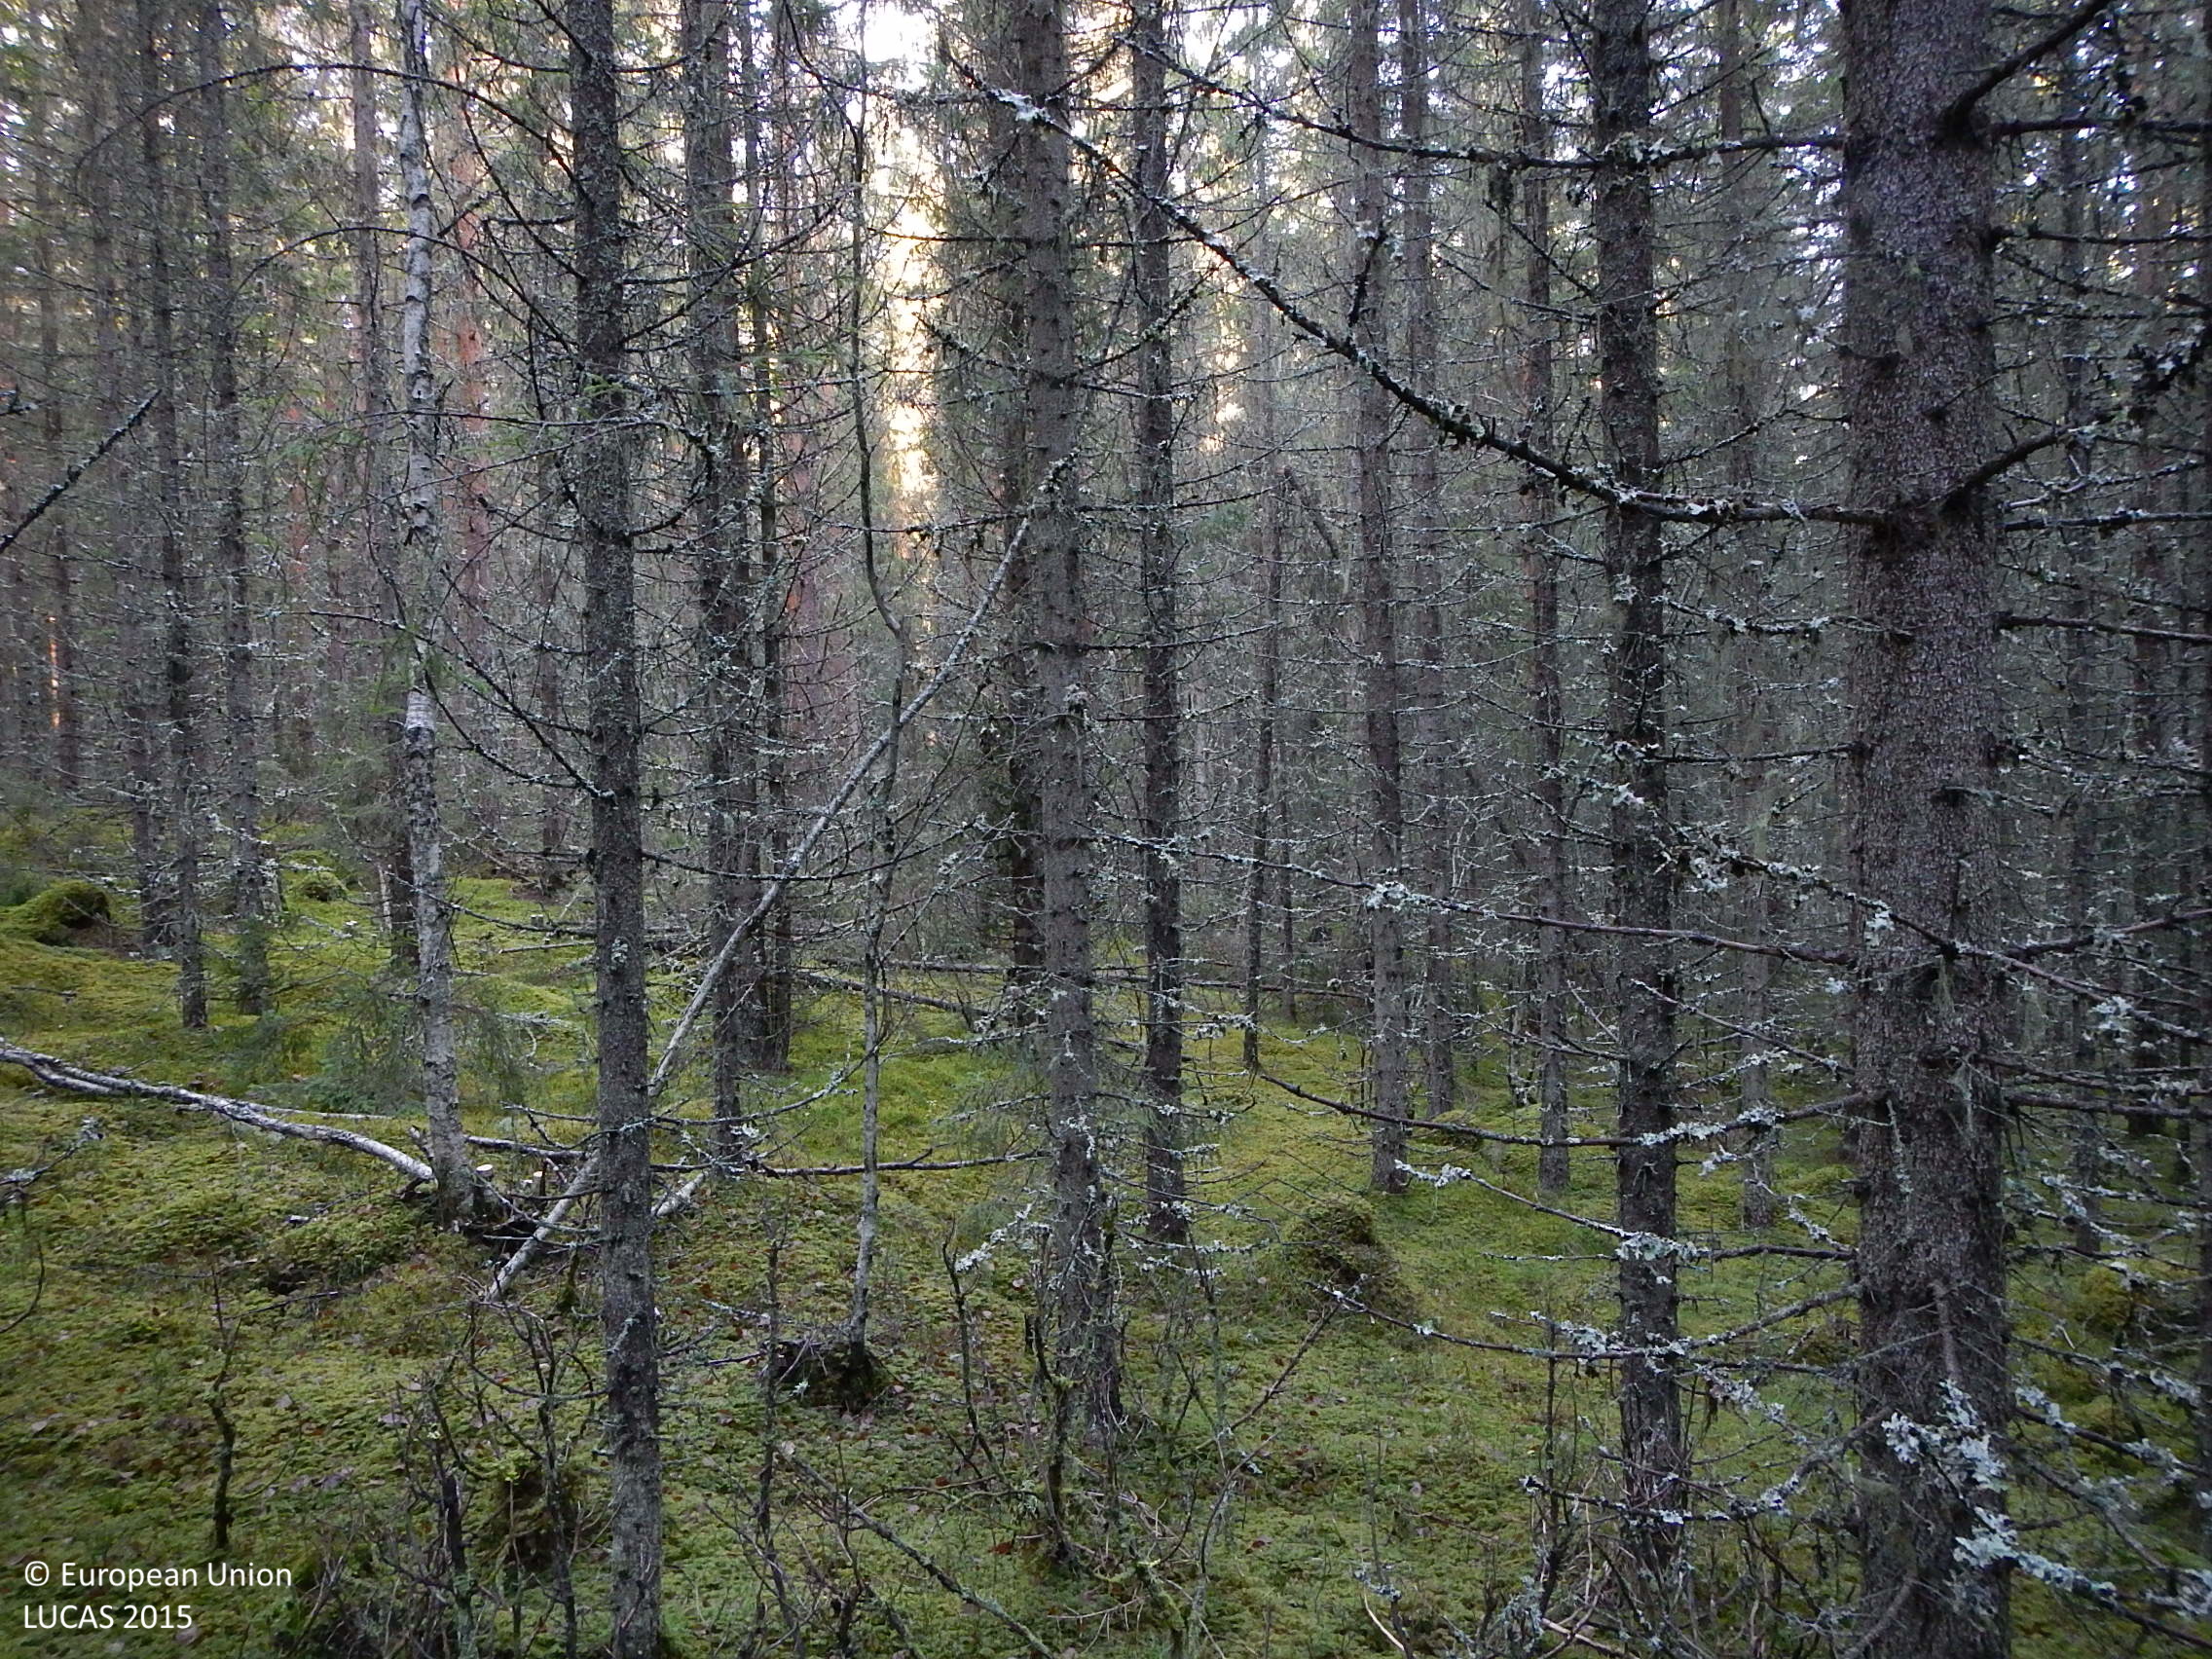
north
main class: Woodland
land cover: Spruce dominated coniferous woodland
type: boreal forest
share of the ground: > 75 %
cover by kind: coniferous forest trees 90 %, lichens and mosses 10 %
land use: Forestry
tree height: > 5 m
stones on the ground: < 10 %
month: November
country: SE
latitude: 61.5155
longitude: 15.5663
